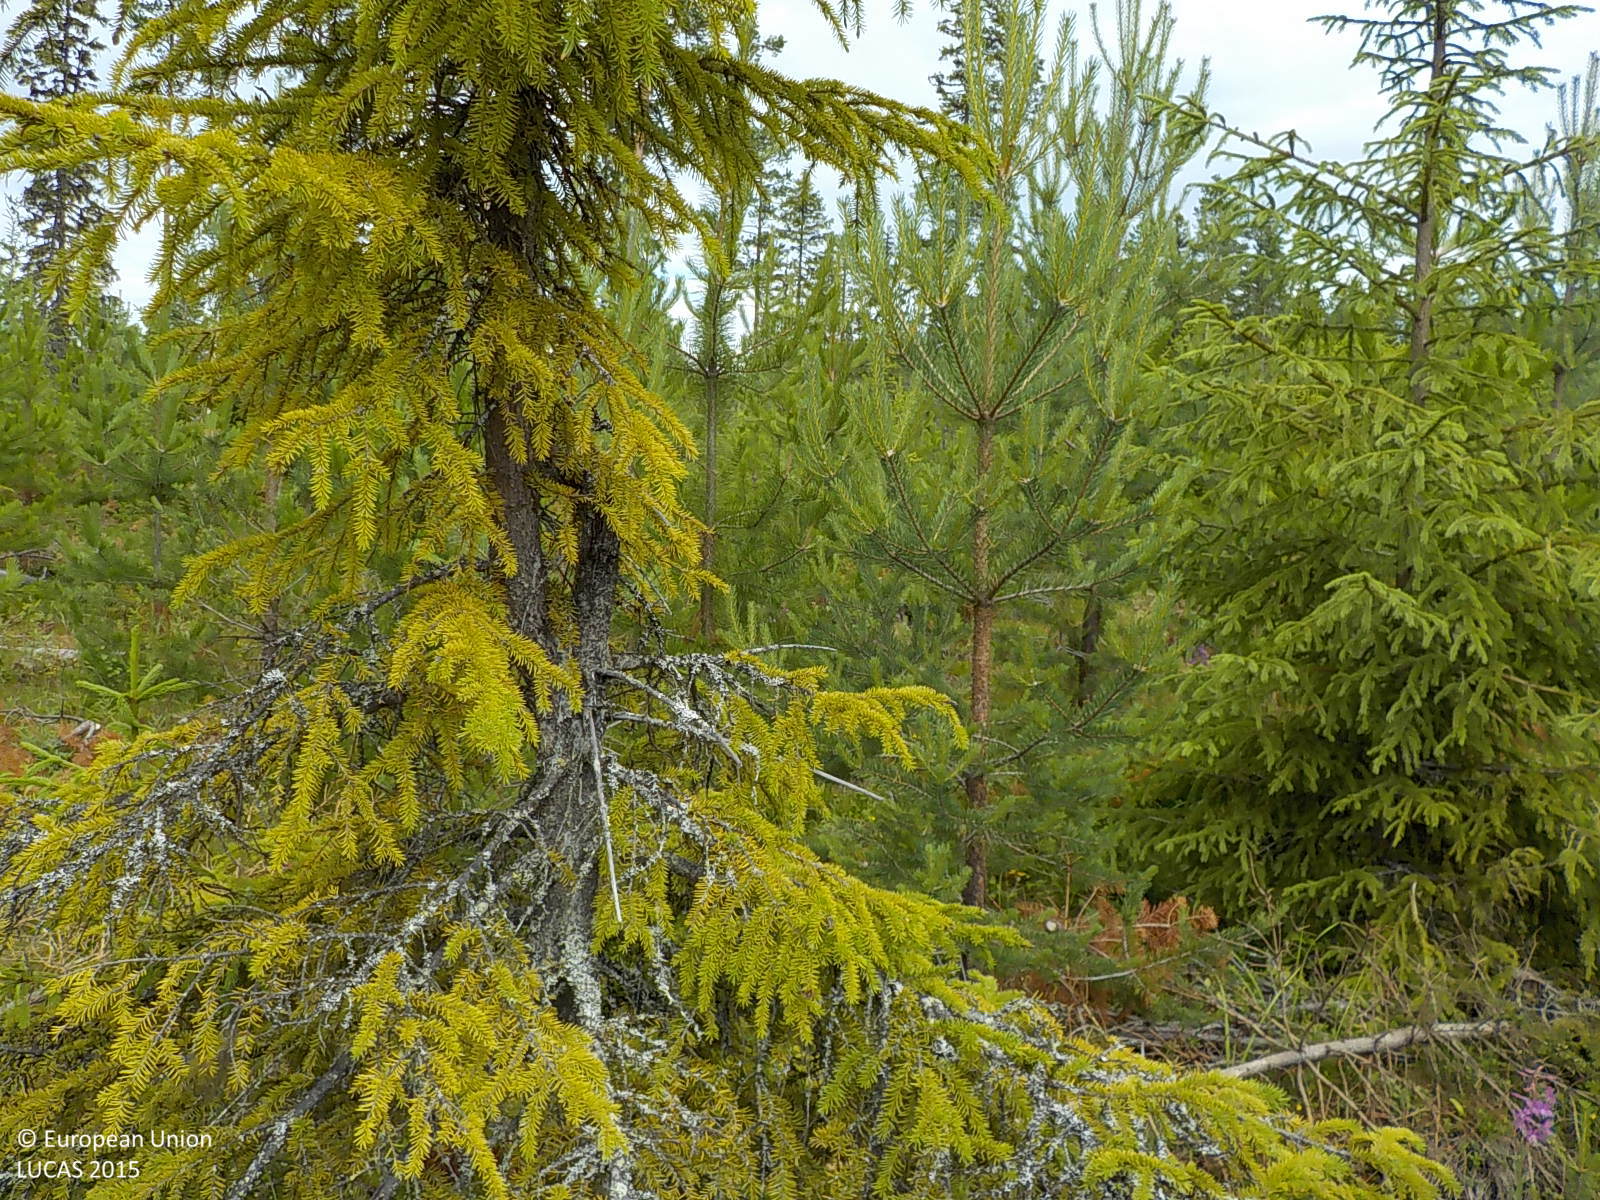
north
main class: Woodland
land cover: Pine dominated coniferous woodland
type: boreal forest
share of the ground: 50 - 75 %
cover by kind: coniferous forest trees 50 %, herbaceous plants 40 %, broadleaved forest trees 5 %, shrubs 5 %
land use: Forestry
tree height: < 5 m
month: July
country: SE
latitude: 63.1977
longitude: 17.2709
